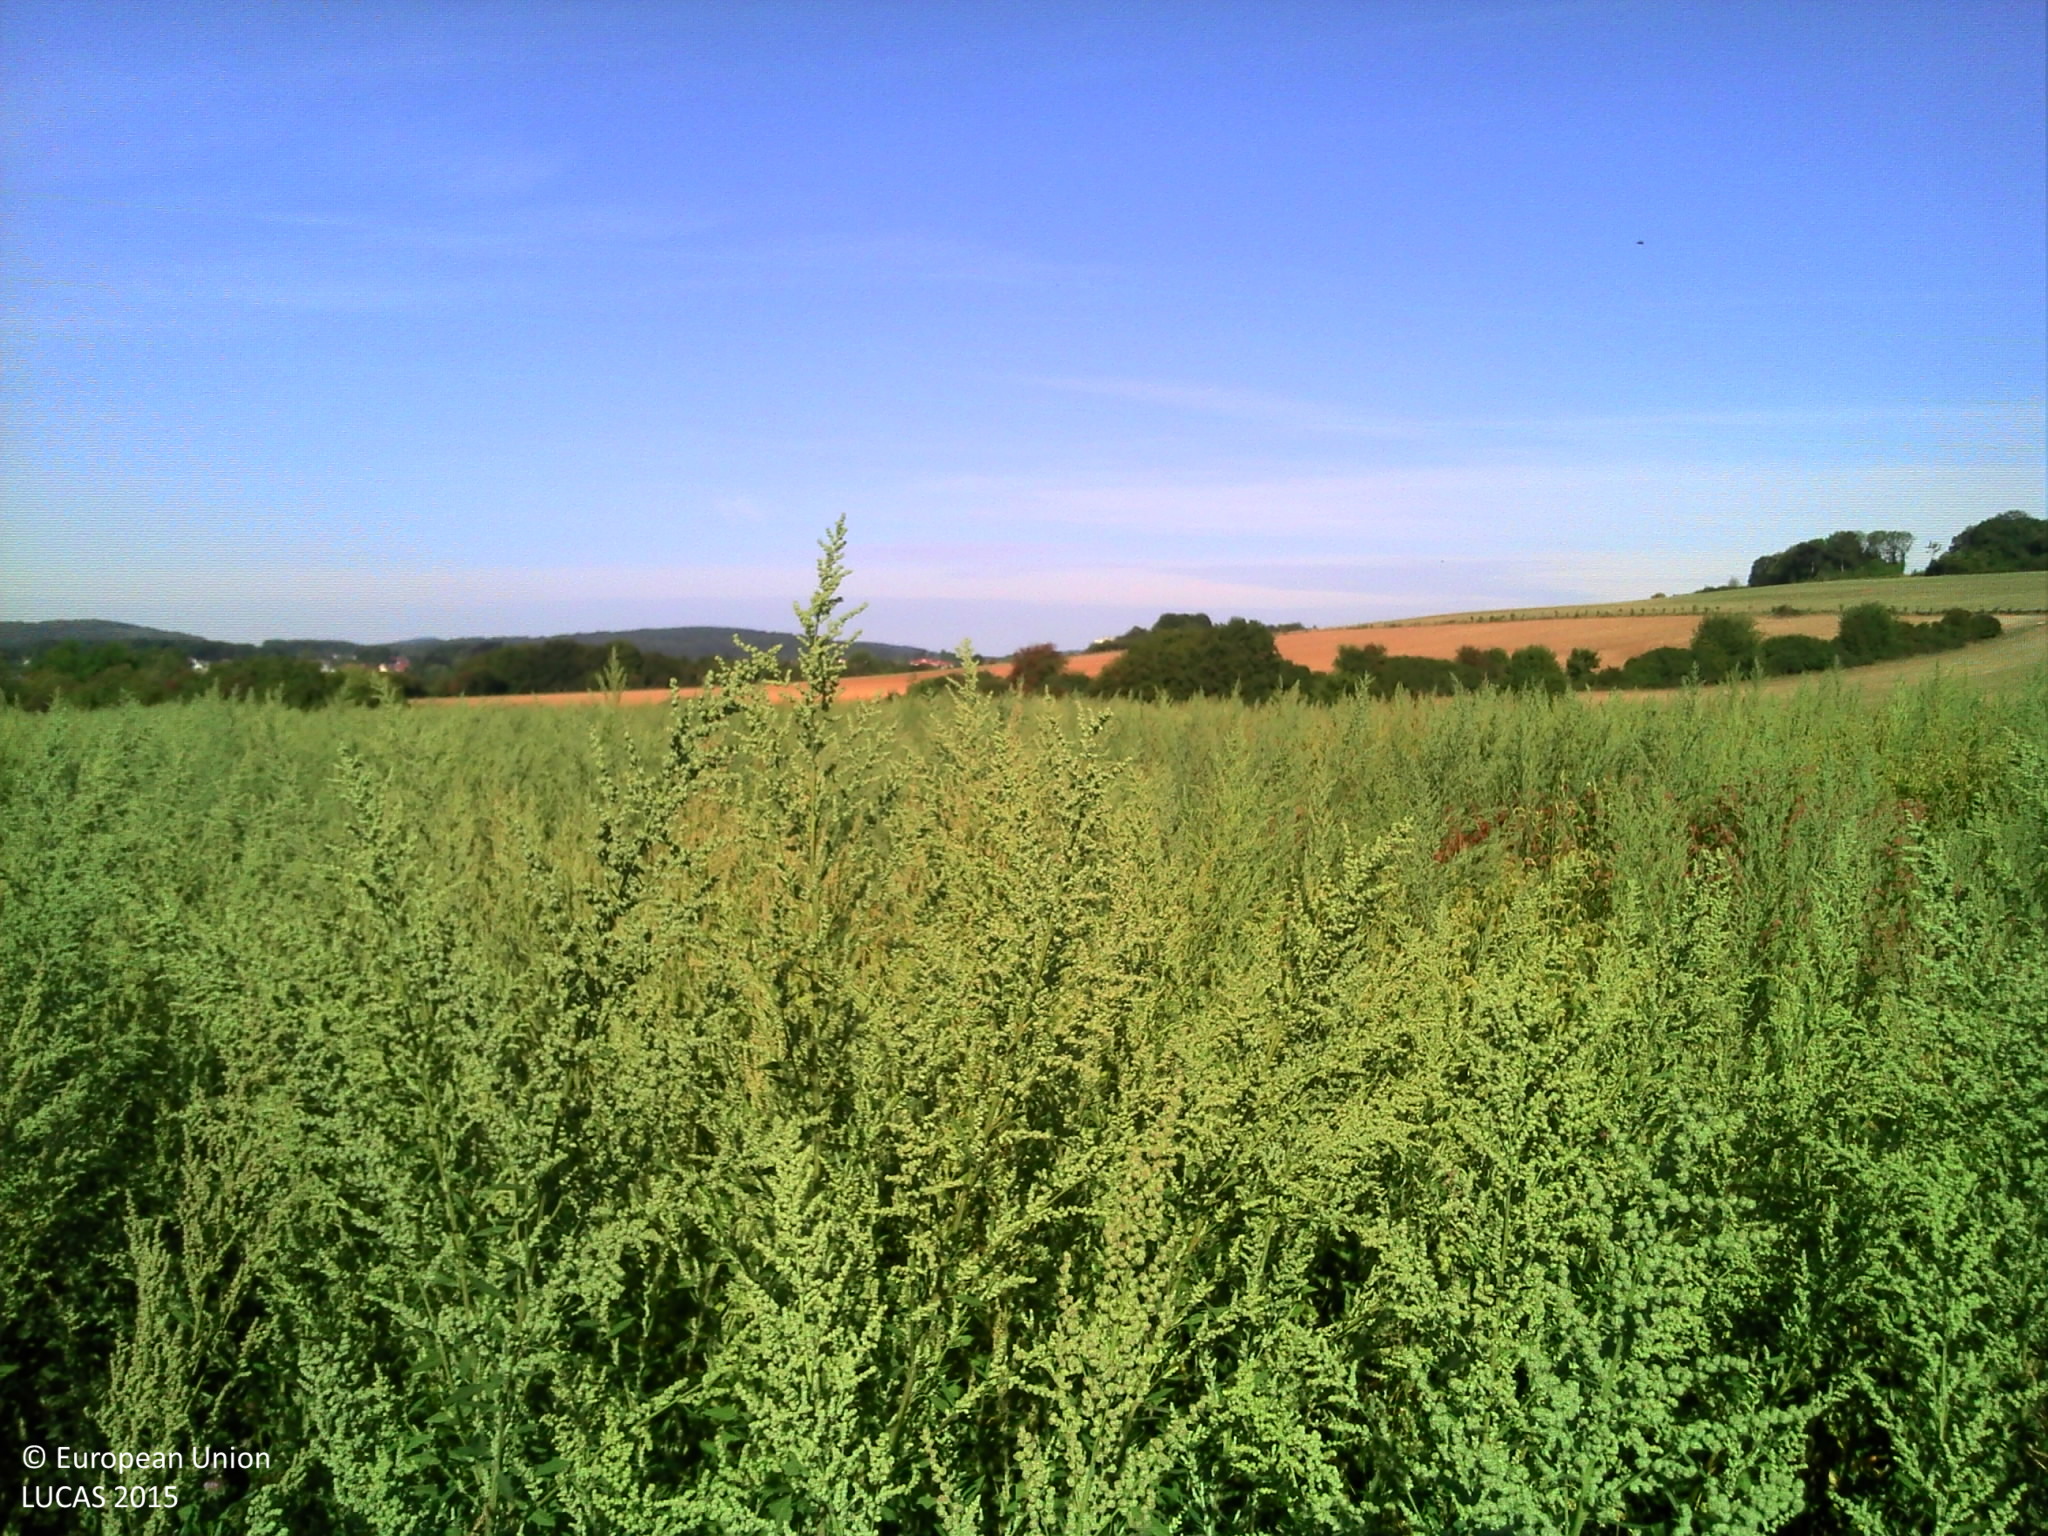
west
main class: Grassland
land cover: Spontaneously vegetated surfaces
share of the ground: > 75 %
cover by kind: herbaceous plants 100 %
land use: Fallow land
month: August
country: FR
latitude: 47.6210
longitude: 6.8747
